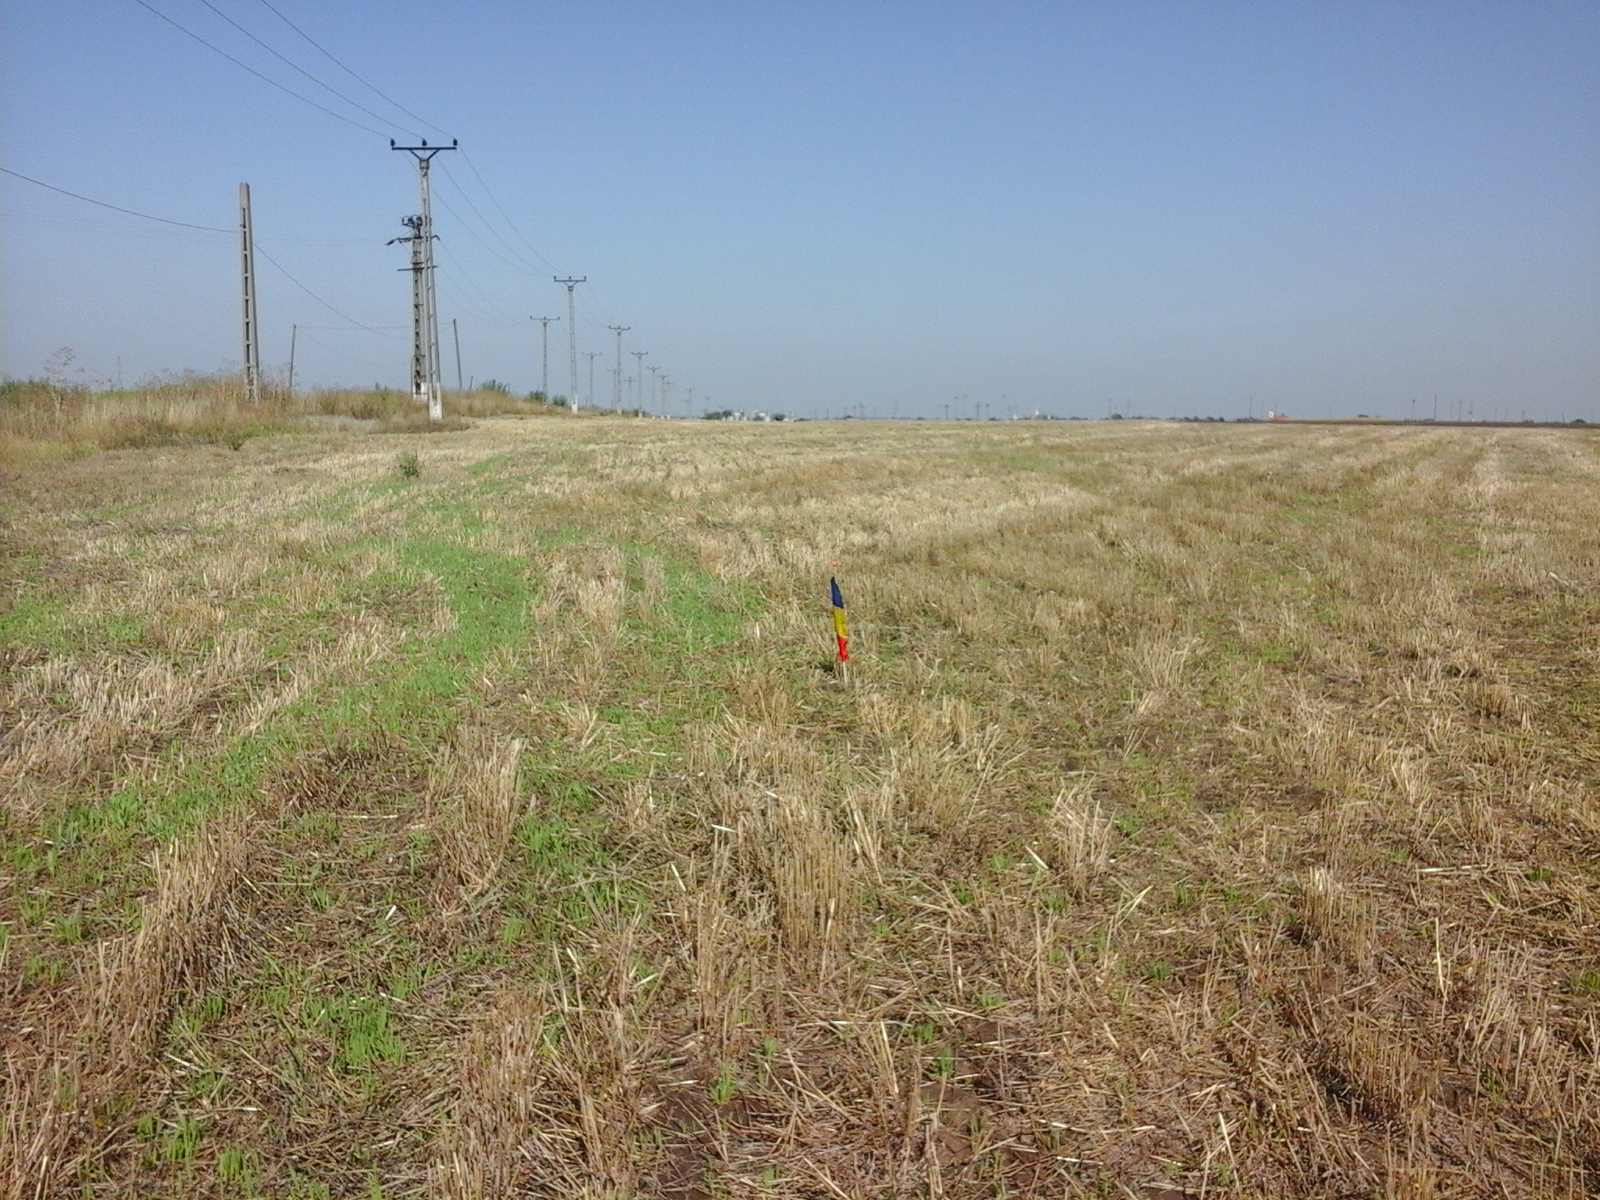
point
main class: Cropland
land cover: Common wheat
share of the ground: 25 - 50 %
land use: Agriculture (excluding fallow land and kitchen gardens)
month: August
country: RO
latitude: 45.9218
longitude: 21.0541
